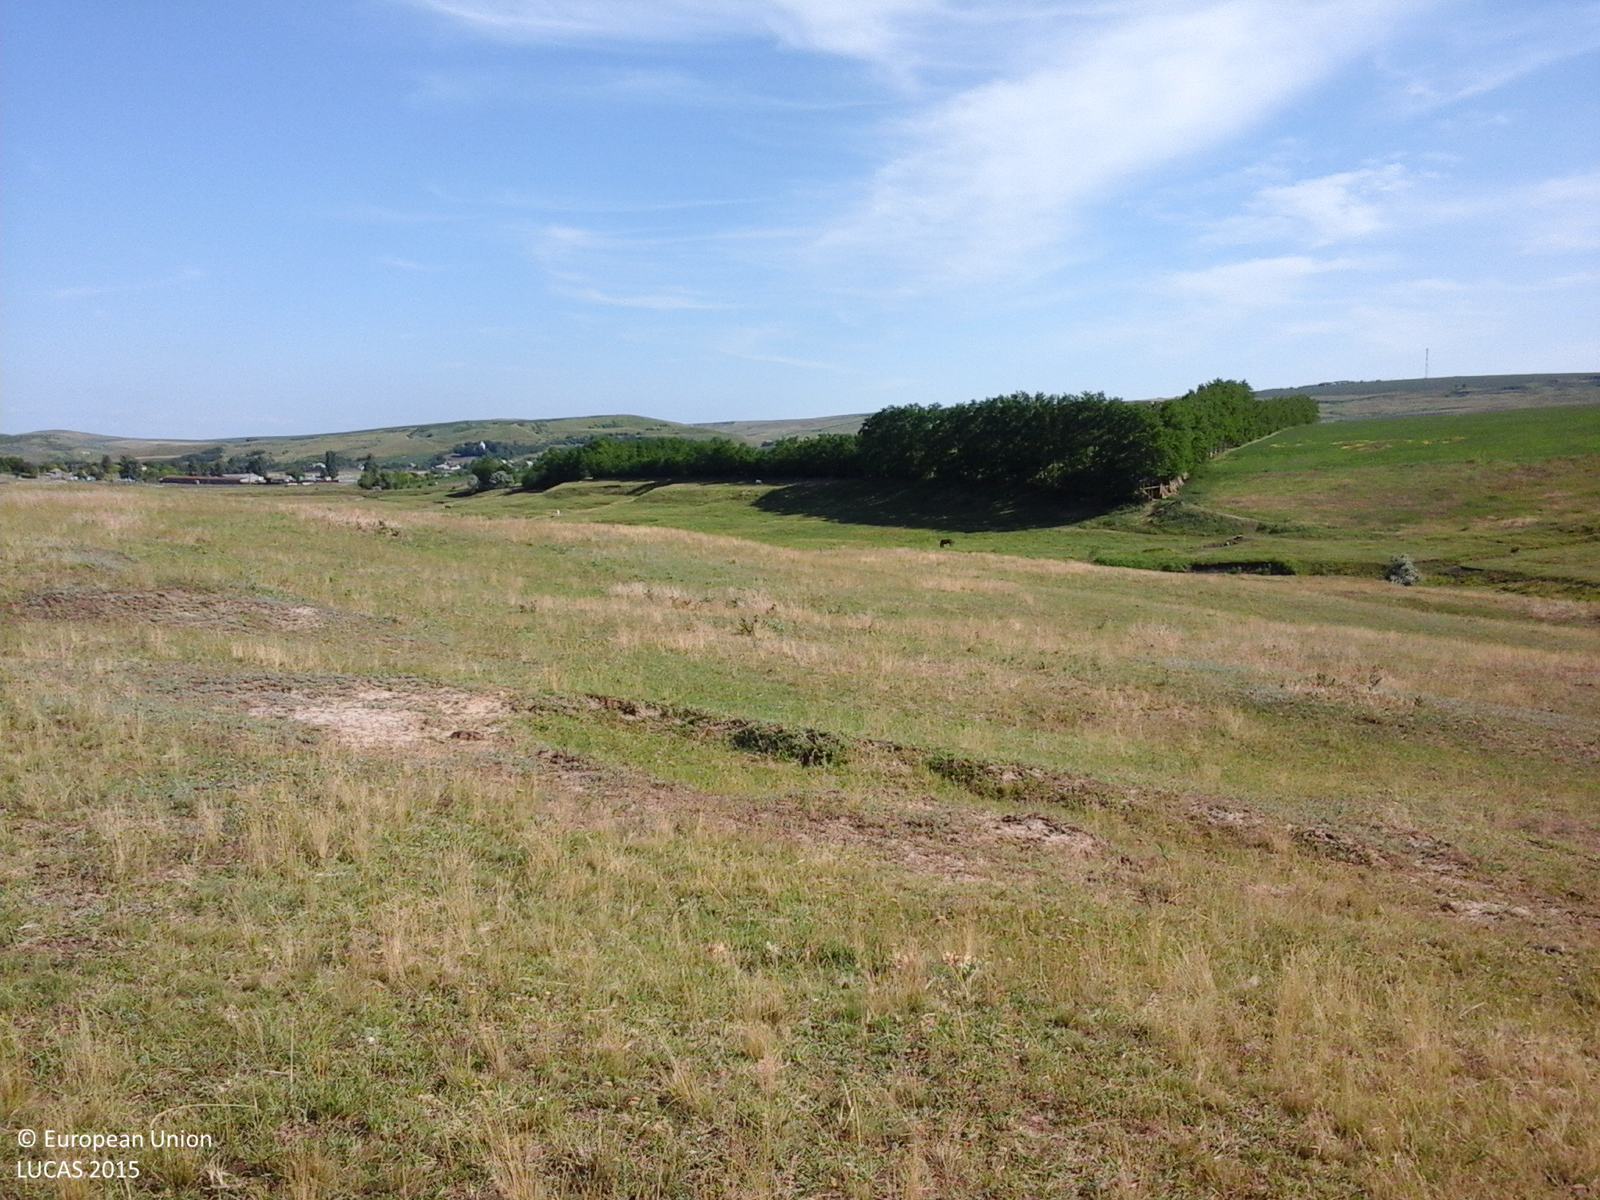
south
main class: Grassland
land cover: Grassland without tree/shrub cover
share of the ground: > 75 %
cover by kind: herbaceous plants 100 %
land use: Agriculture (excluding fallow land and kitchen gardens)
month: June
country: RO
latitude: 47.4976
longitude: 27.1112
